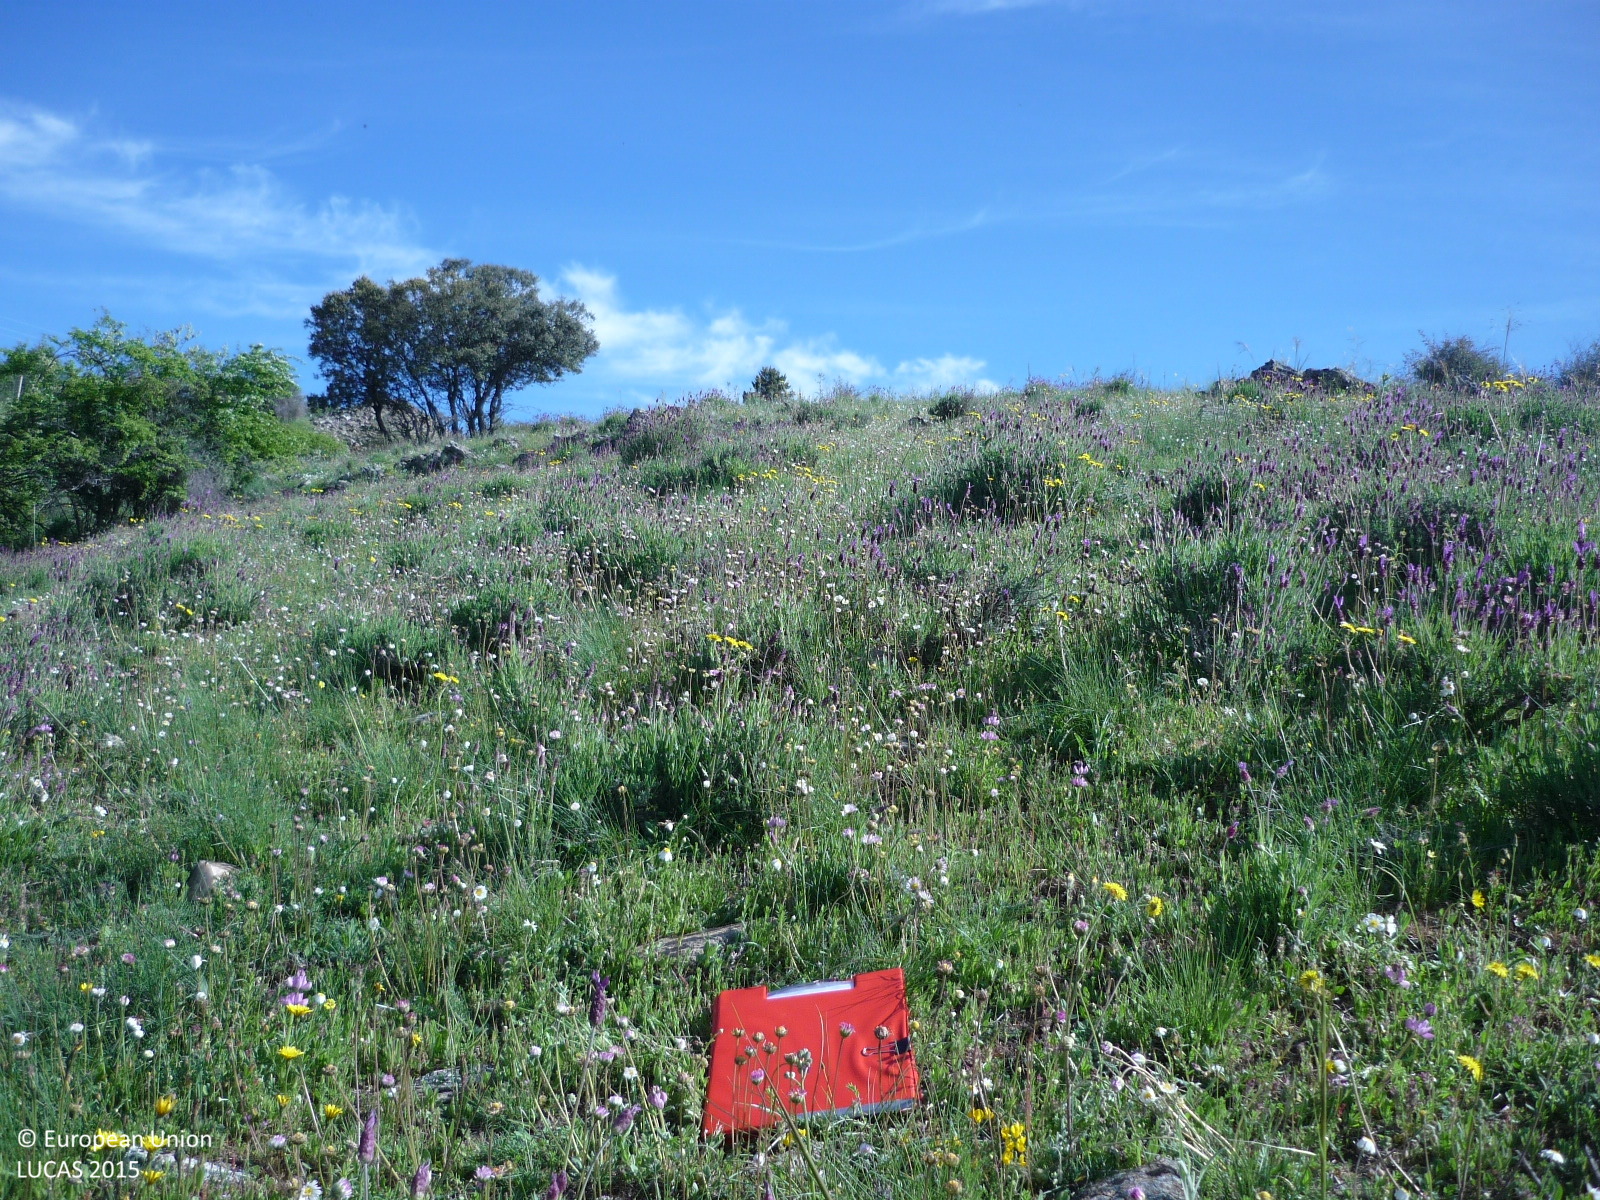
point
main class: Grassland
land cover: Grassland with sparse tree/shrub cover
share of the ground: > 75 %
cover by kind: herbaceous plants 85 %, shrubs 10 %, broadleaved forest trees 5 %
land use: Agriculture (excluding fallow land and kitchen gardens)
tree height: < 5 m
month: May
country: ES
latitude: 41.0280
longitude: -3.6628
